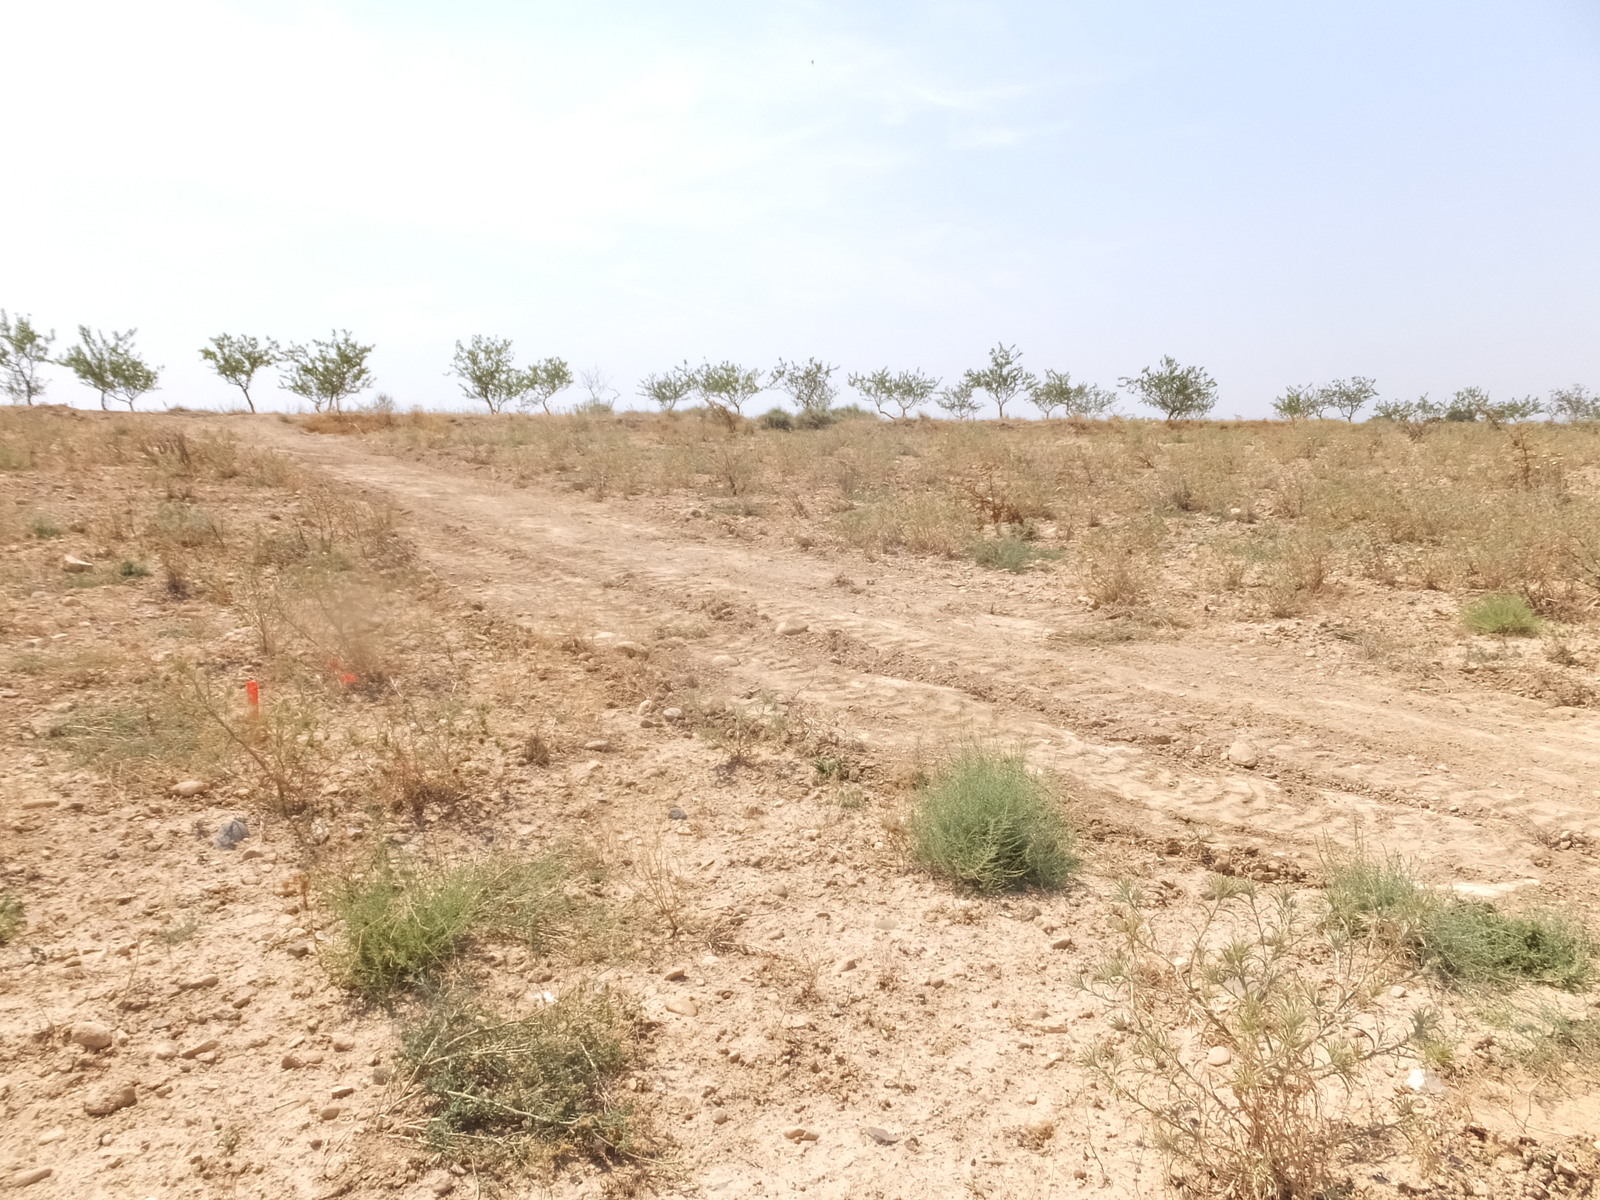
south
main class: Grassland
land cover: Spontaneously vegetated surfaces
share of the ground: > 75 %
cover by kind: herbaceous plants 75 %, unconsolidated bare surface 20 %, shrubs 5 %
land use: Fallow land
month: July
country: ES
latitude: 41.6908
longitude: 0.2412
